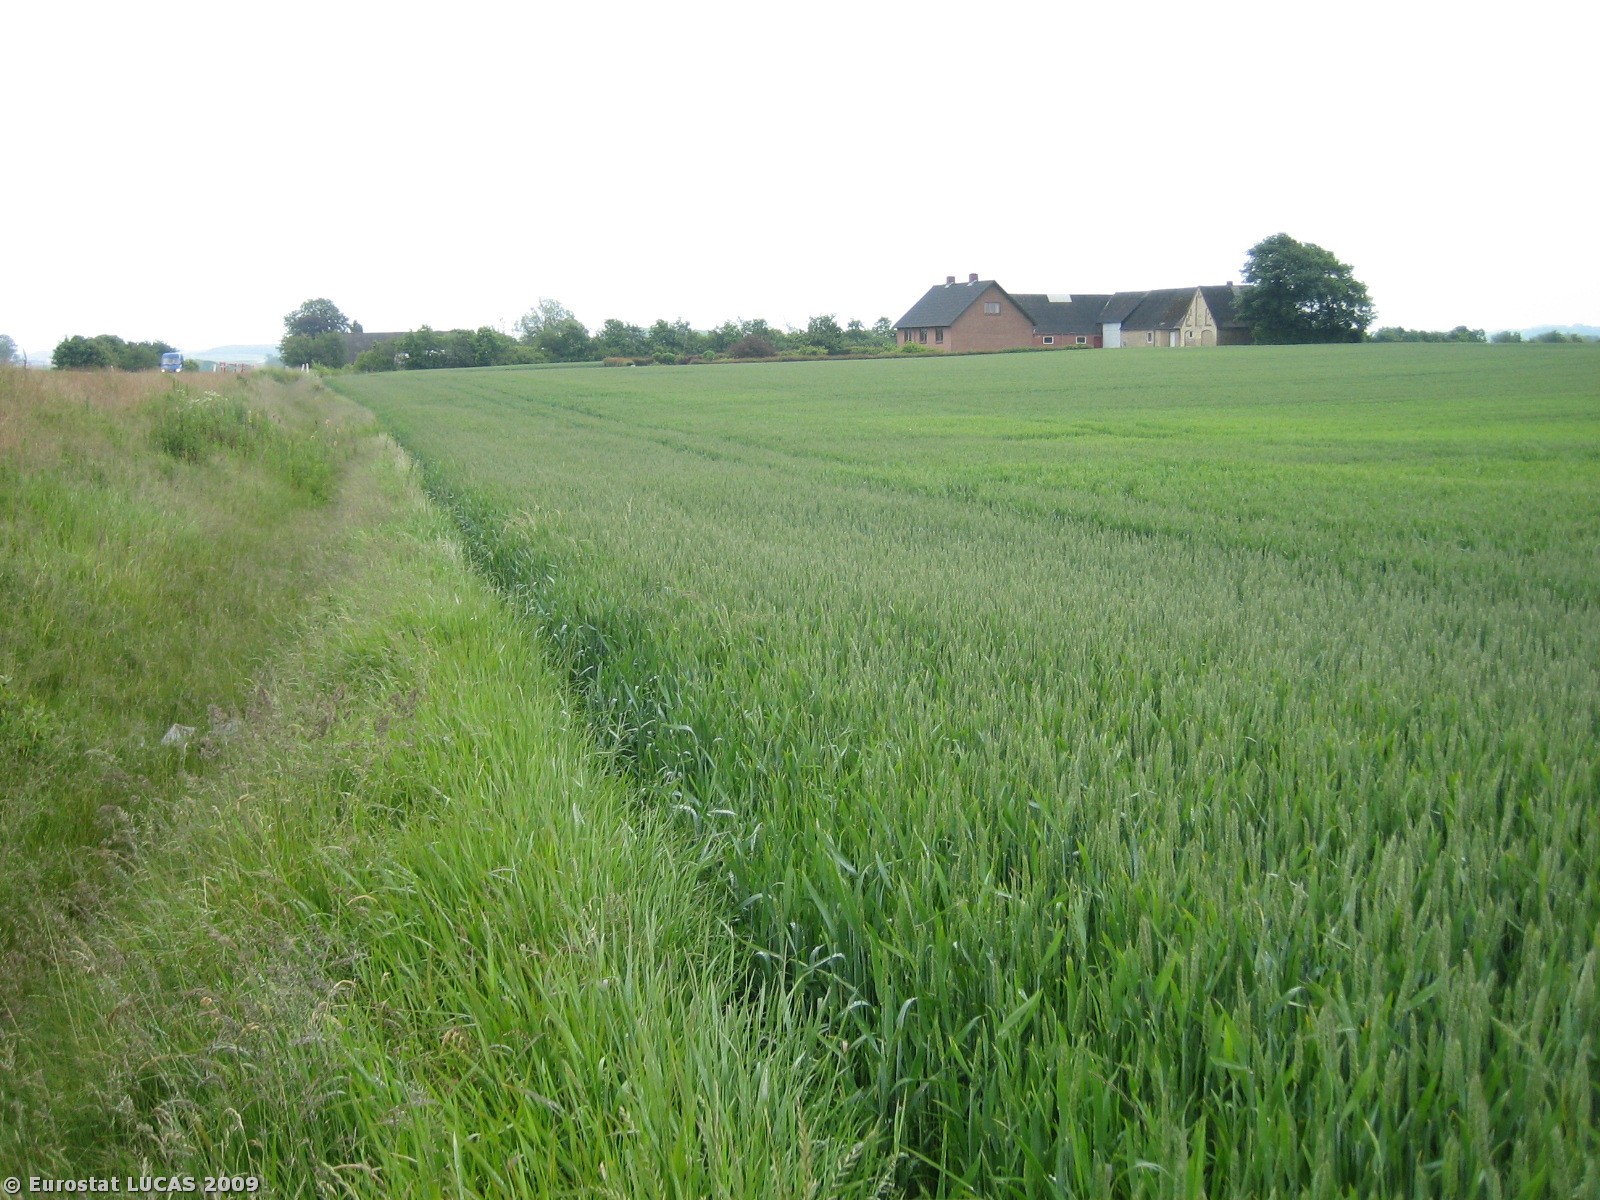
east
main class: Cropland
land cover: Common wheat
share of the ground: > 75 %
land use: Agriculture (excluding fallow land and kitchen gardens)
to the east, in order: Common wheat; Managed hedges; Tracks; Shrubland without tree cover; Bare land; Shrubland without tree cover; Managed hedges; Common wheat; Fences; Broadleaved woodland; Fences; Grassland without tree/shrub cover; Fences; Grassland without tree/shrub cover
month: June
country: DK
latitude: 56.1518
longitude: 10.0161
